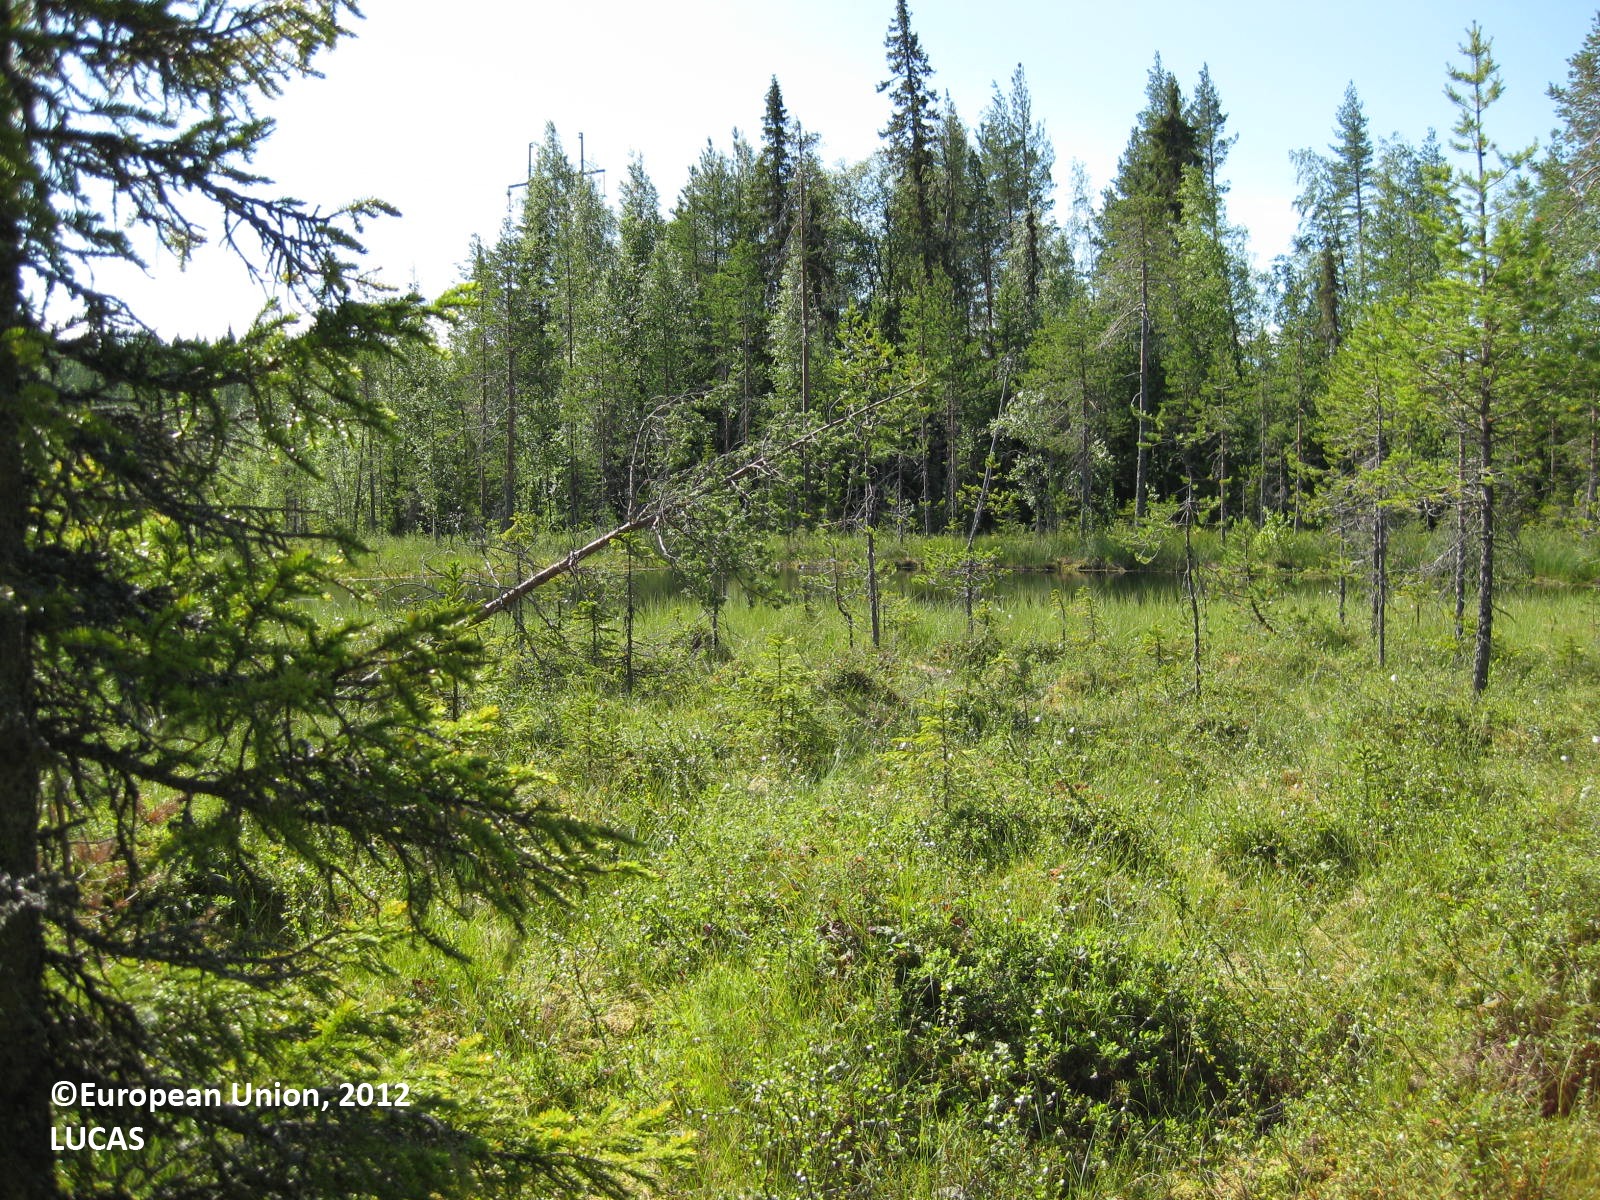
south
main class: Woodland
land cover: Spruce dominated mixed woodland
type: boreal forest
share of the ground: 50 - 75 %
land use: Semi-natural and natural areas not in use
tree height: > 5 m
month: July
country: FI
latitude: 65.5869
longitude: 28.3922
